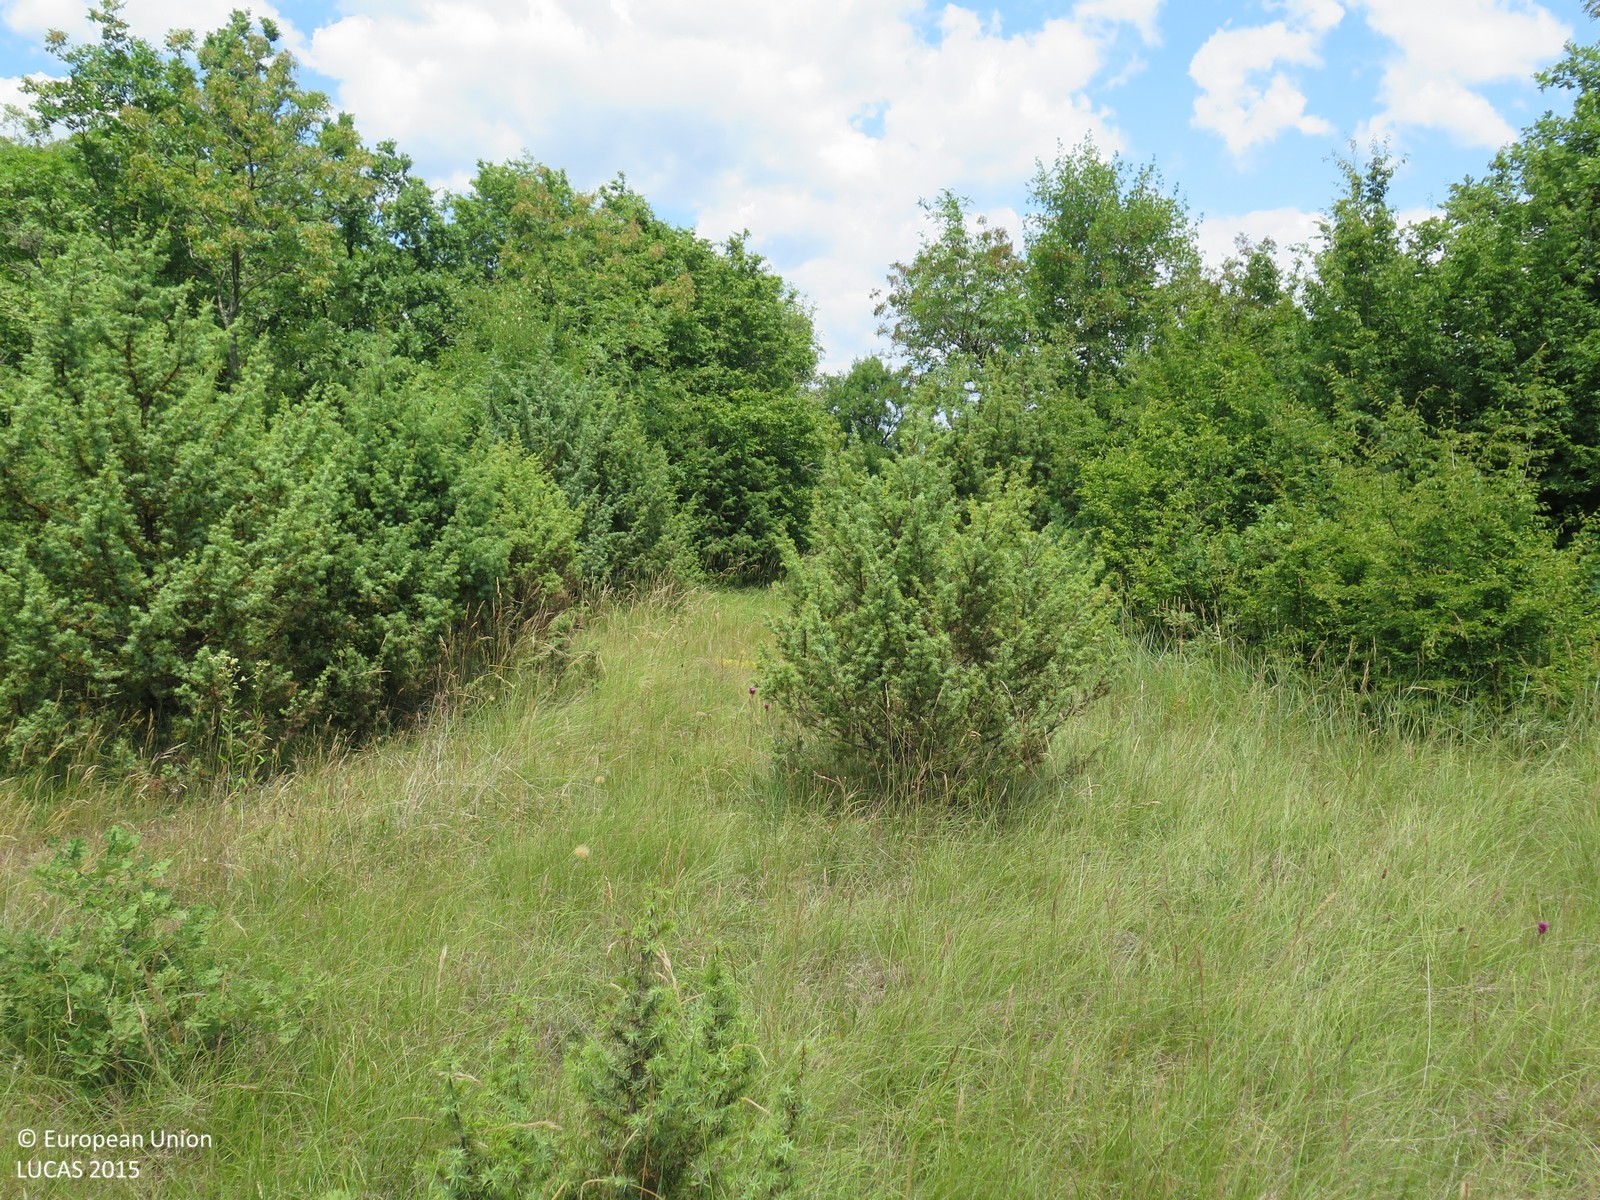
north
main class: Grassland
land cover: Grassland with sparse tree/shrub cover
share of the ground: > 75 %
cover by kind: herbaceous plants 90 %, broadleaved forest trees 5 %, shrubs 5 %
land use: Semi-natural and natural areas not in use
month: June
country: HR
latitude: 45.0640
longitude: 14.0965
